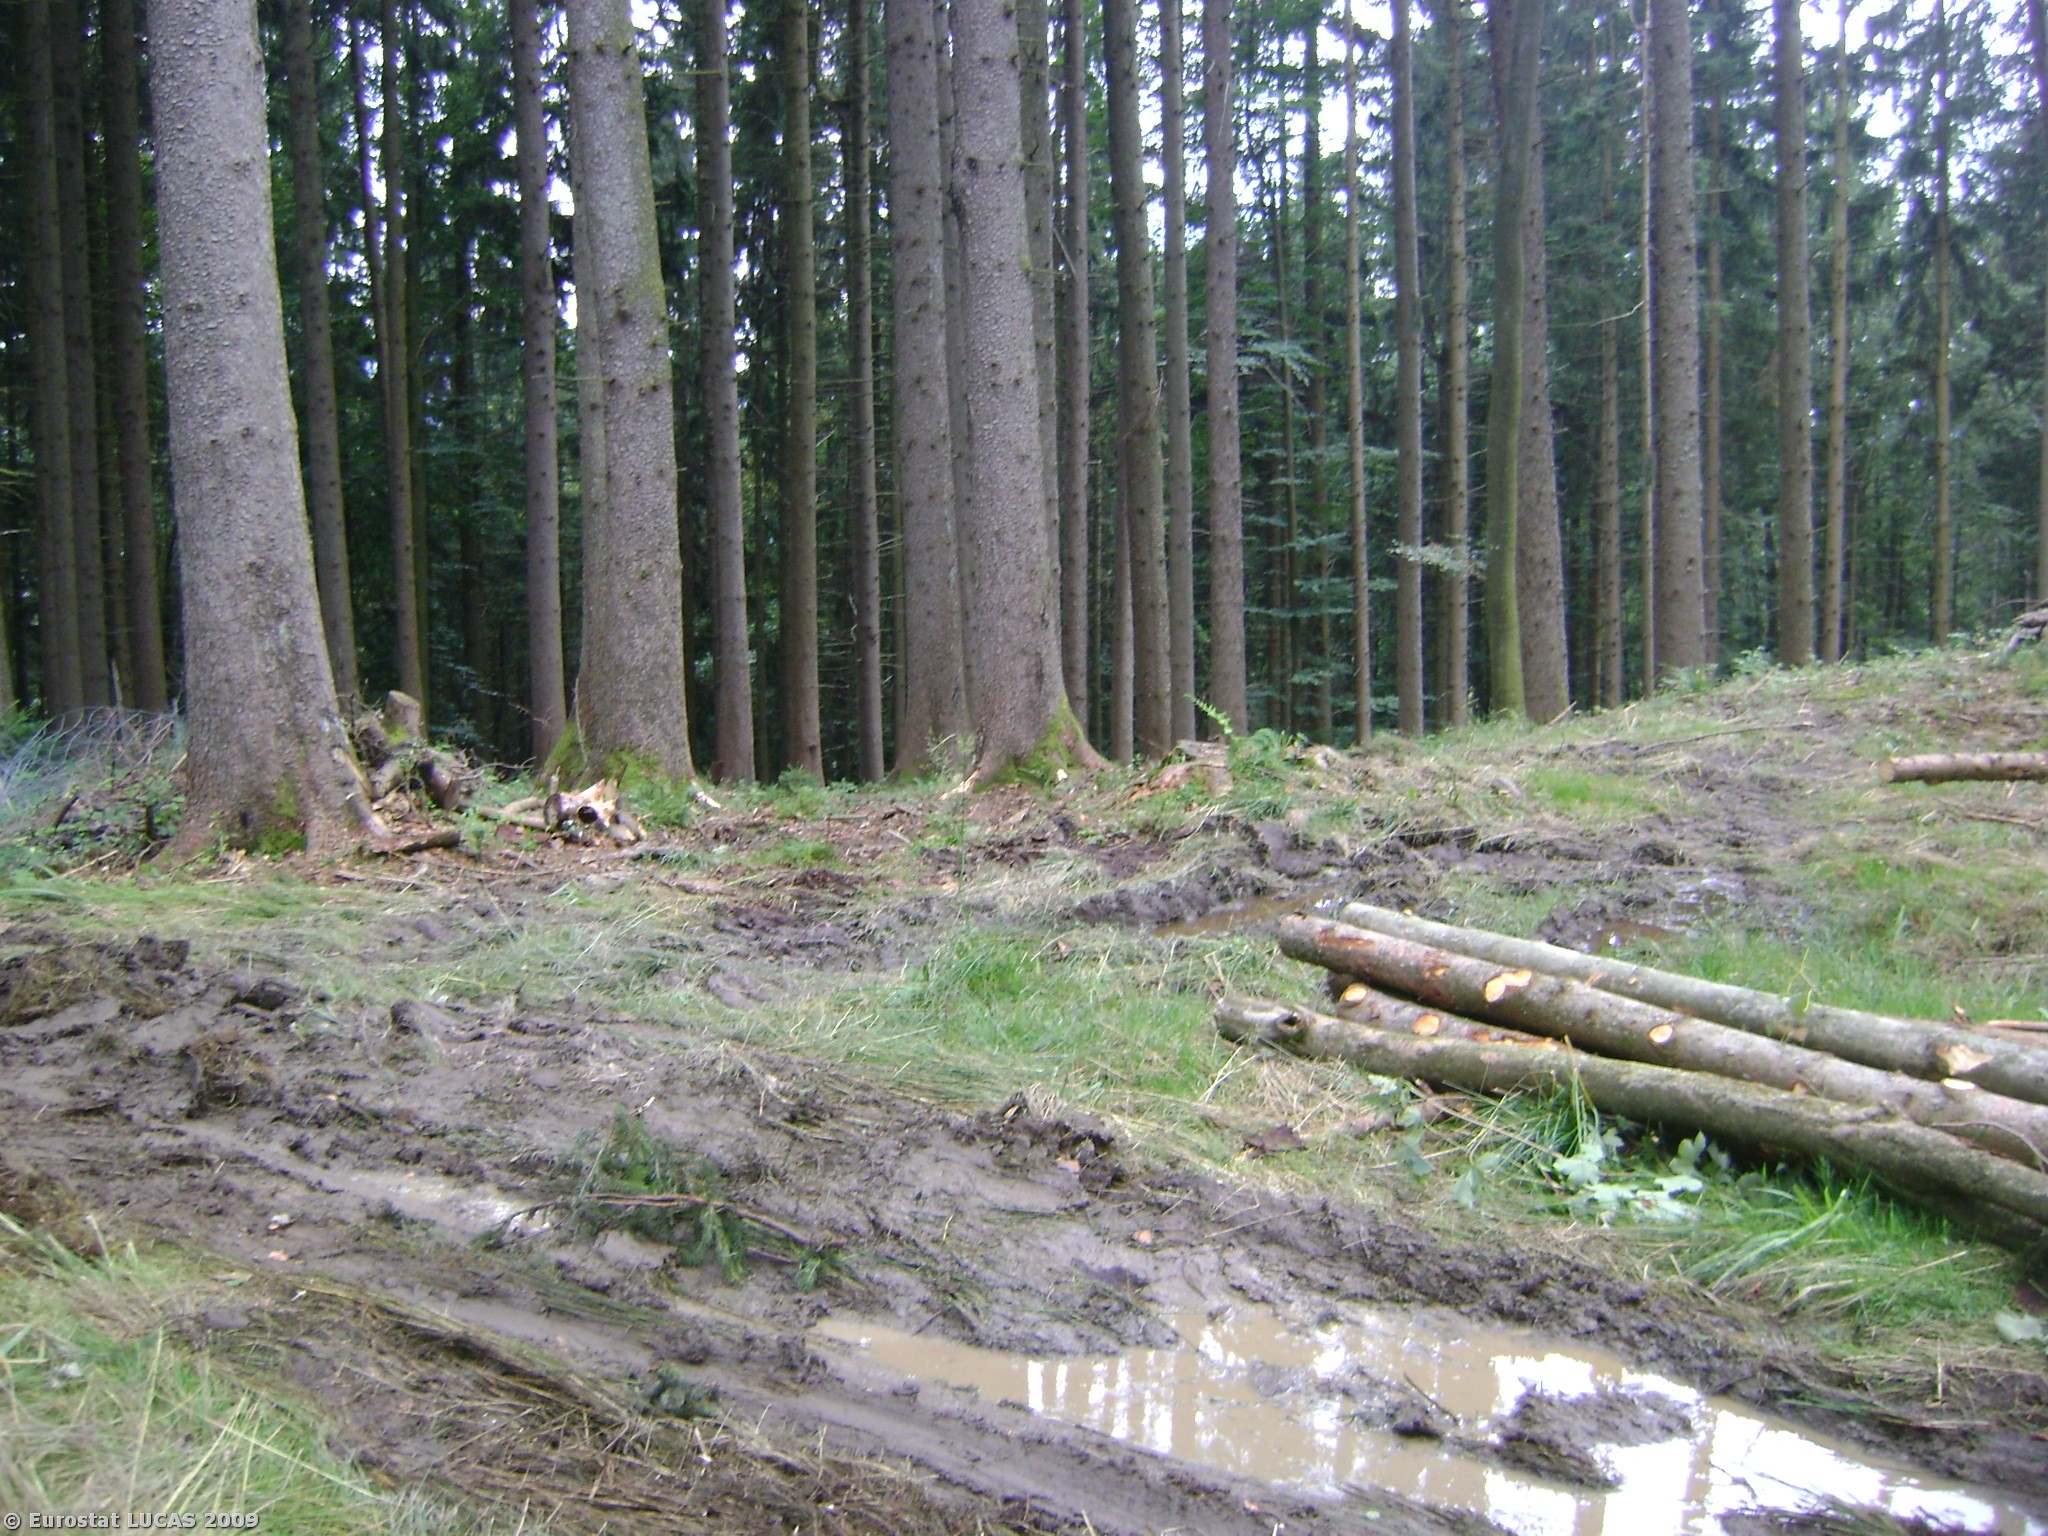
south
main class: Shrubland
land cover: Shrubland with sparse tree cover
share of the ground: > 75 %
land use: Forestry
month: August
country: AT
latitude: 47.8704
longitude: 13.2207
